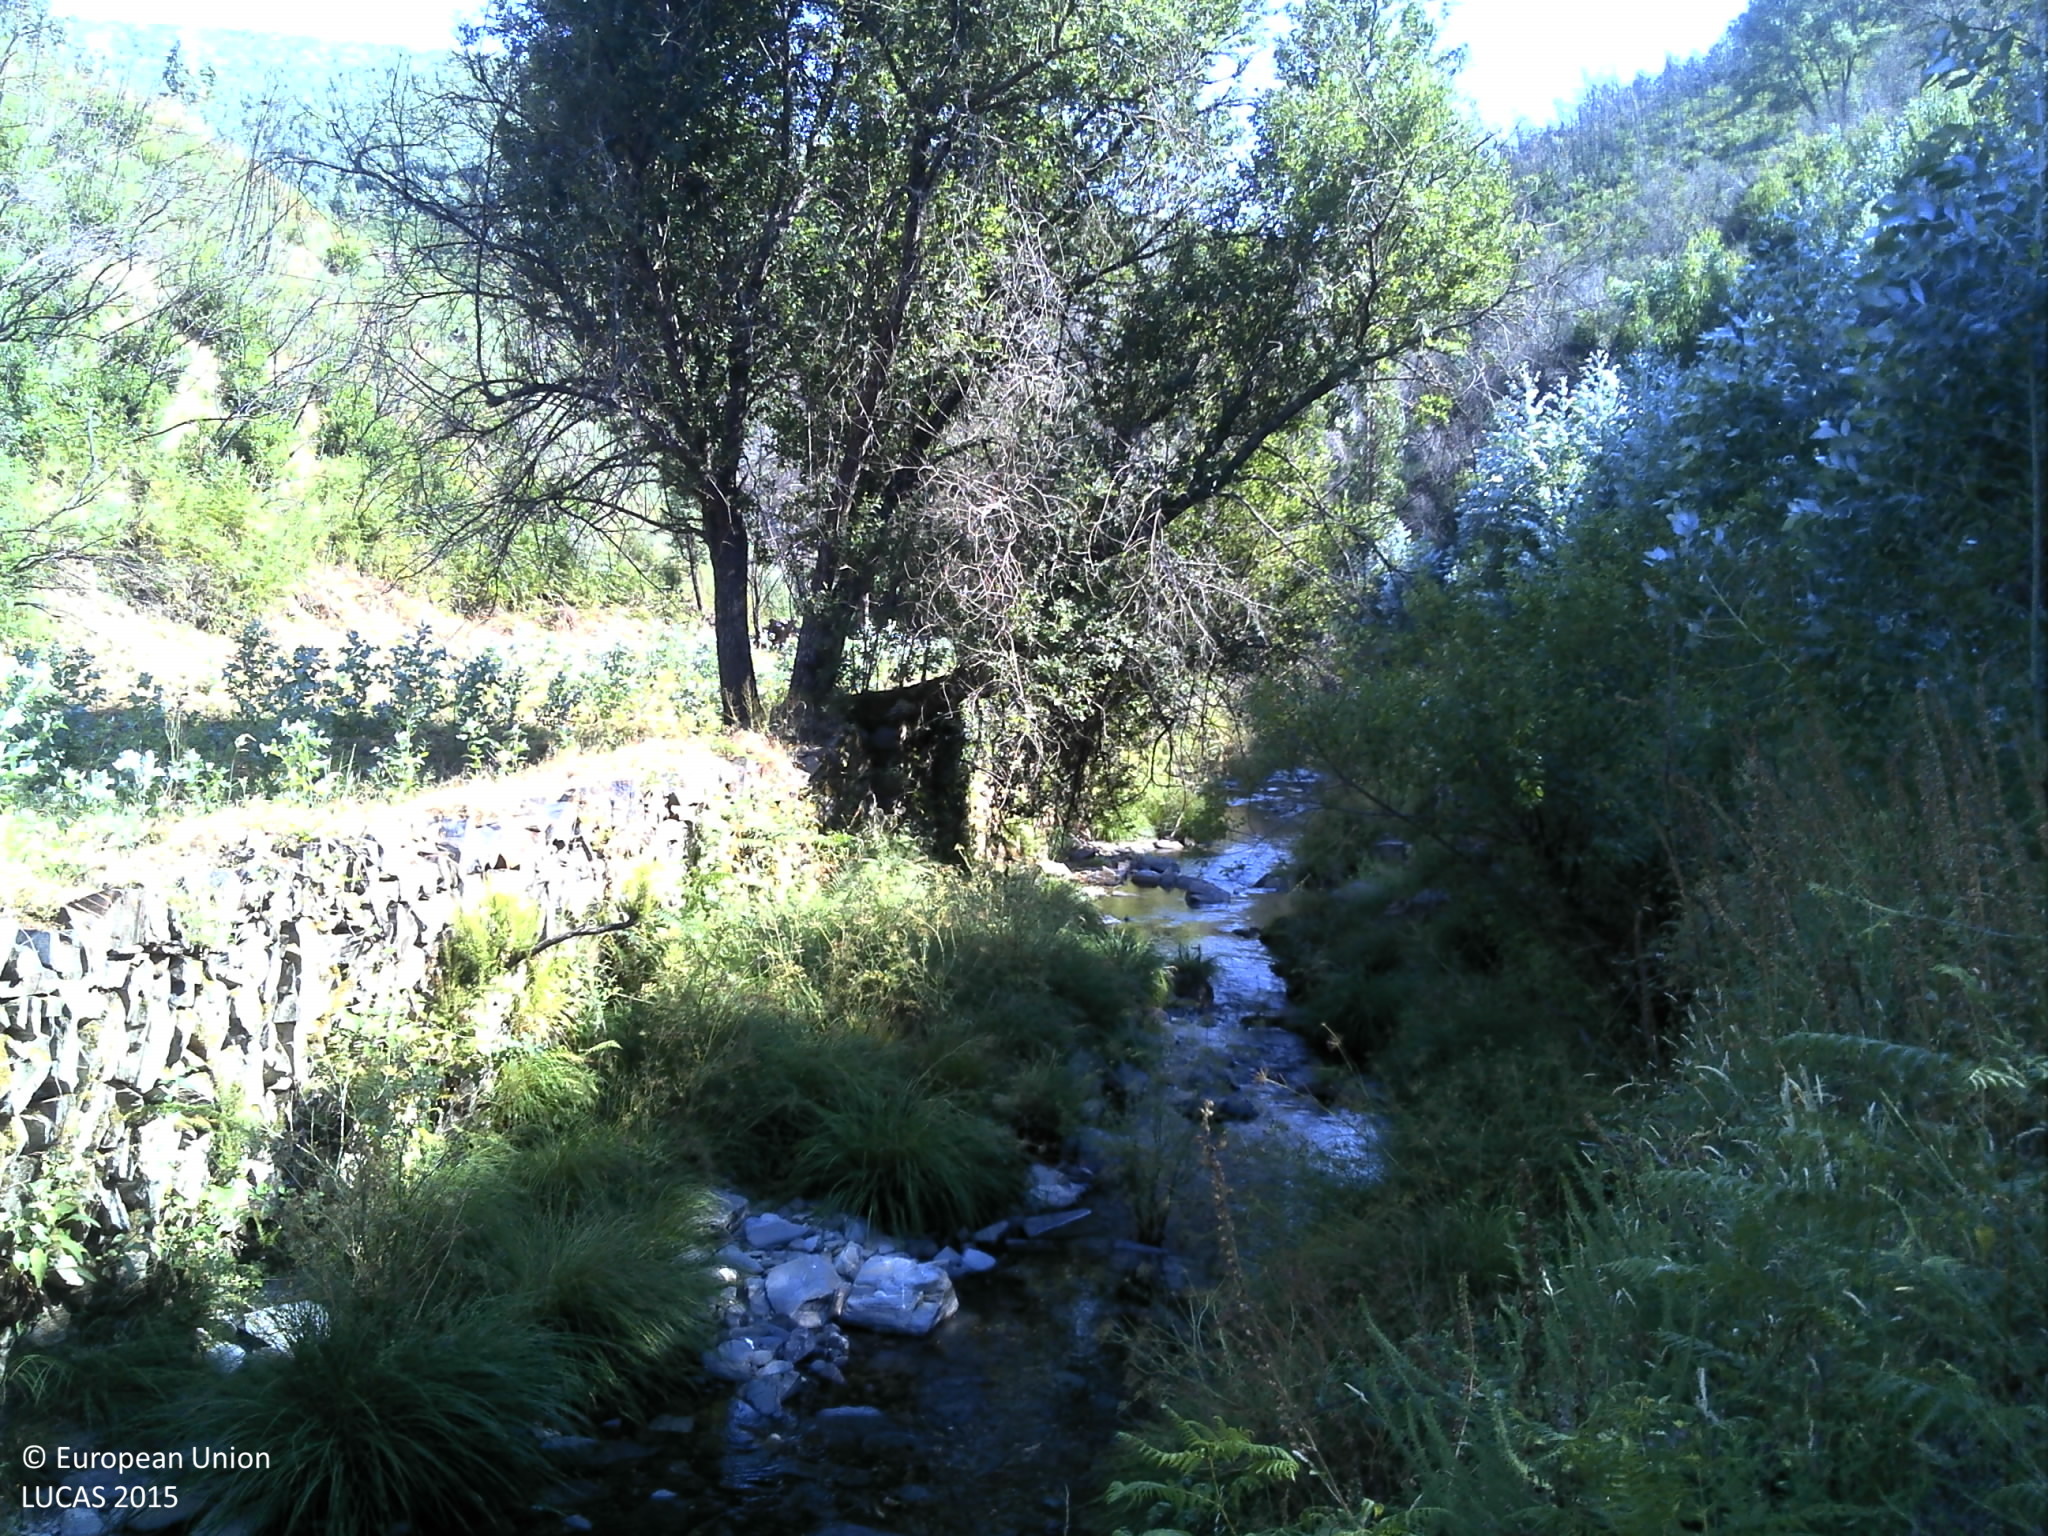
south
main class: Shrubland
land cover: Shrubland with sparse tree cover
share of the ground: > 75 %
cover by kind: shrubs 80 %, unconsolidated bare surface 15 %, broadleaved forest trees 5 %
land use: Abandoned areas
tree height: < 5 m
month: June
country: PT
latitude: 40.0489
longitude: -8.0876
